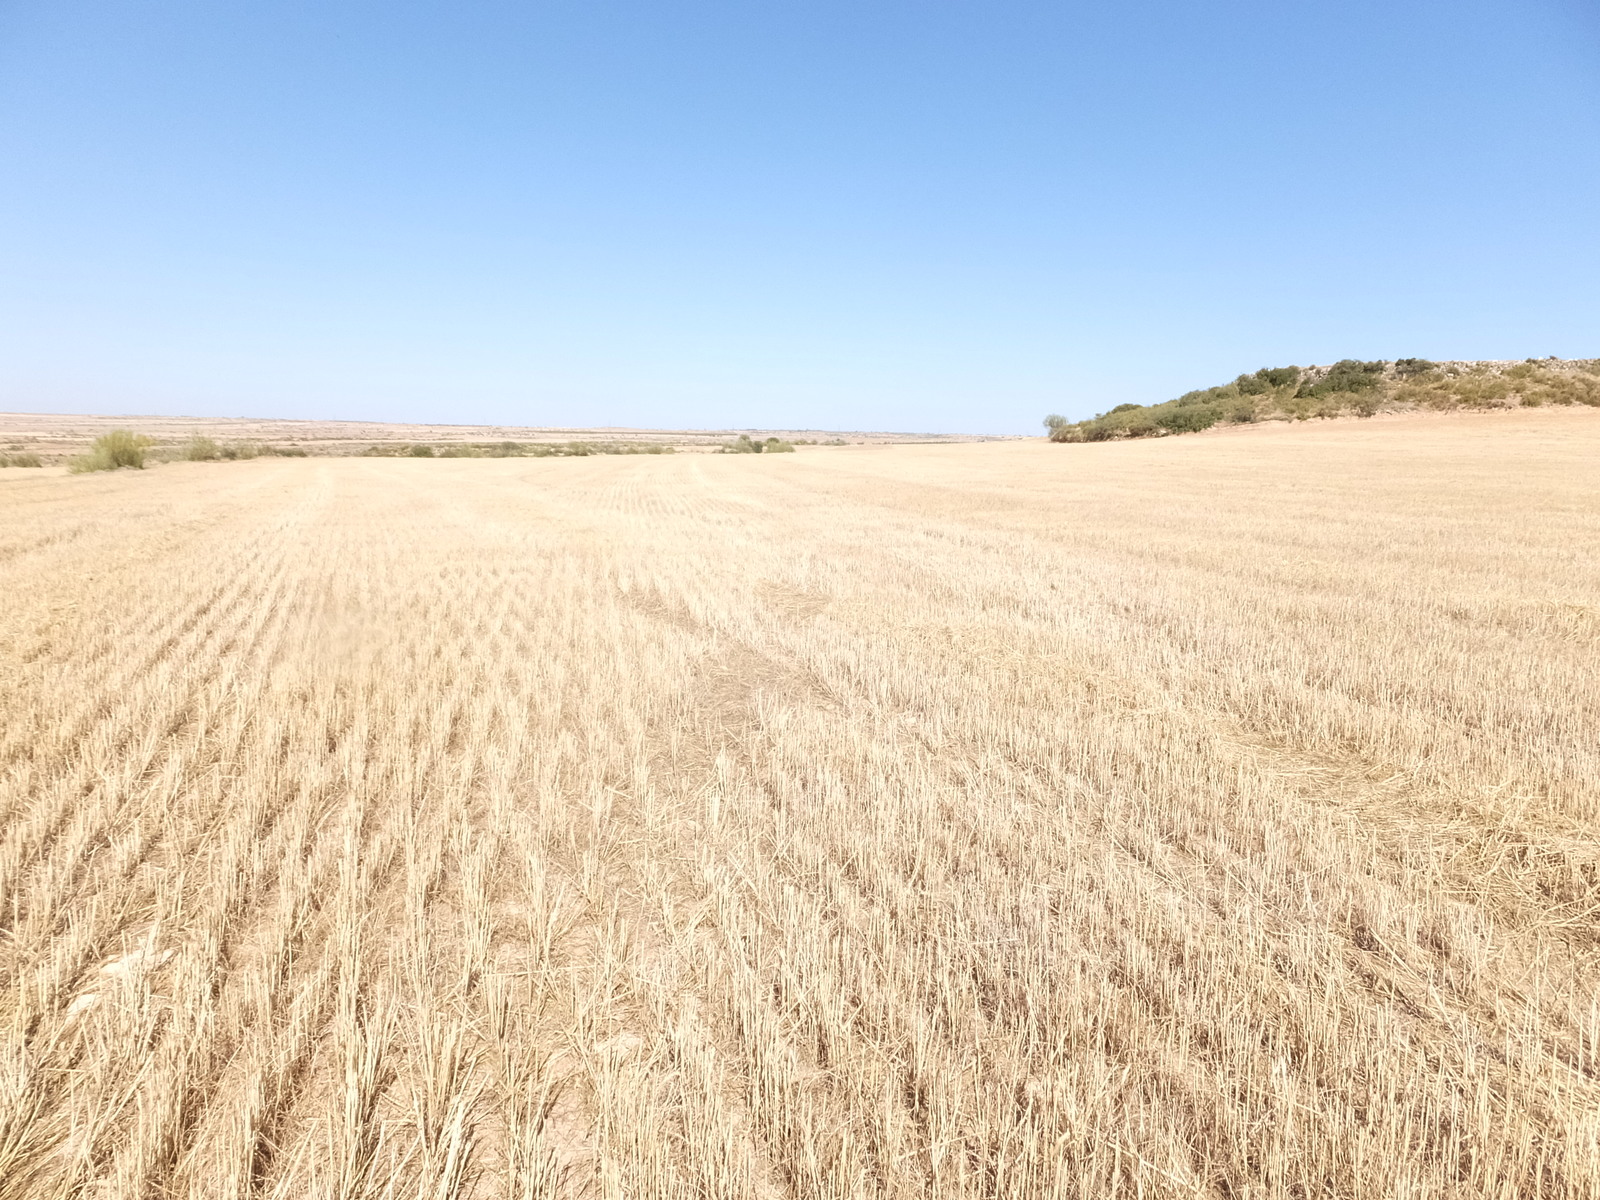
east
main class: Cropland
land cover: Common wheat
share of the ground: < 10 %
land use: Agriculture (excluding fallow land and kitchen gardens)
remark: Harvested field
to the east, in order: Common wheat; Dry stone walls; Shrubland without tree cover
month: July
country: ES
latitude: 41.4487
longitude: 0.1834
